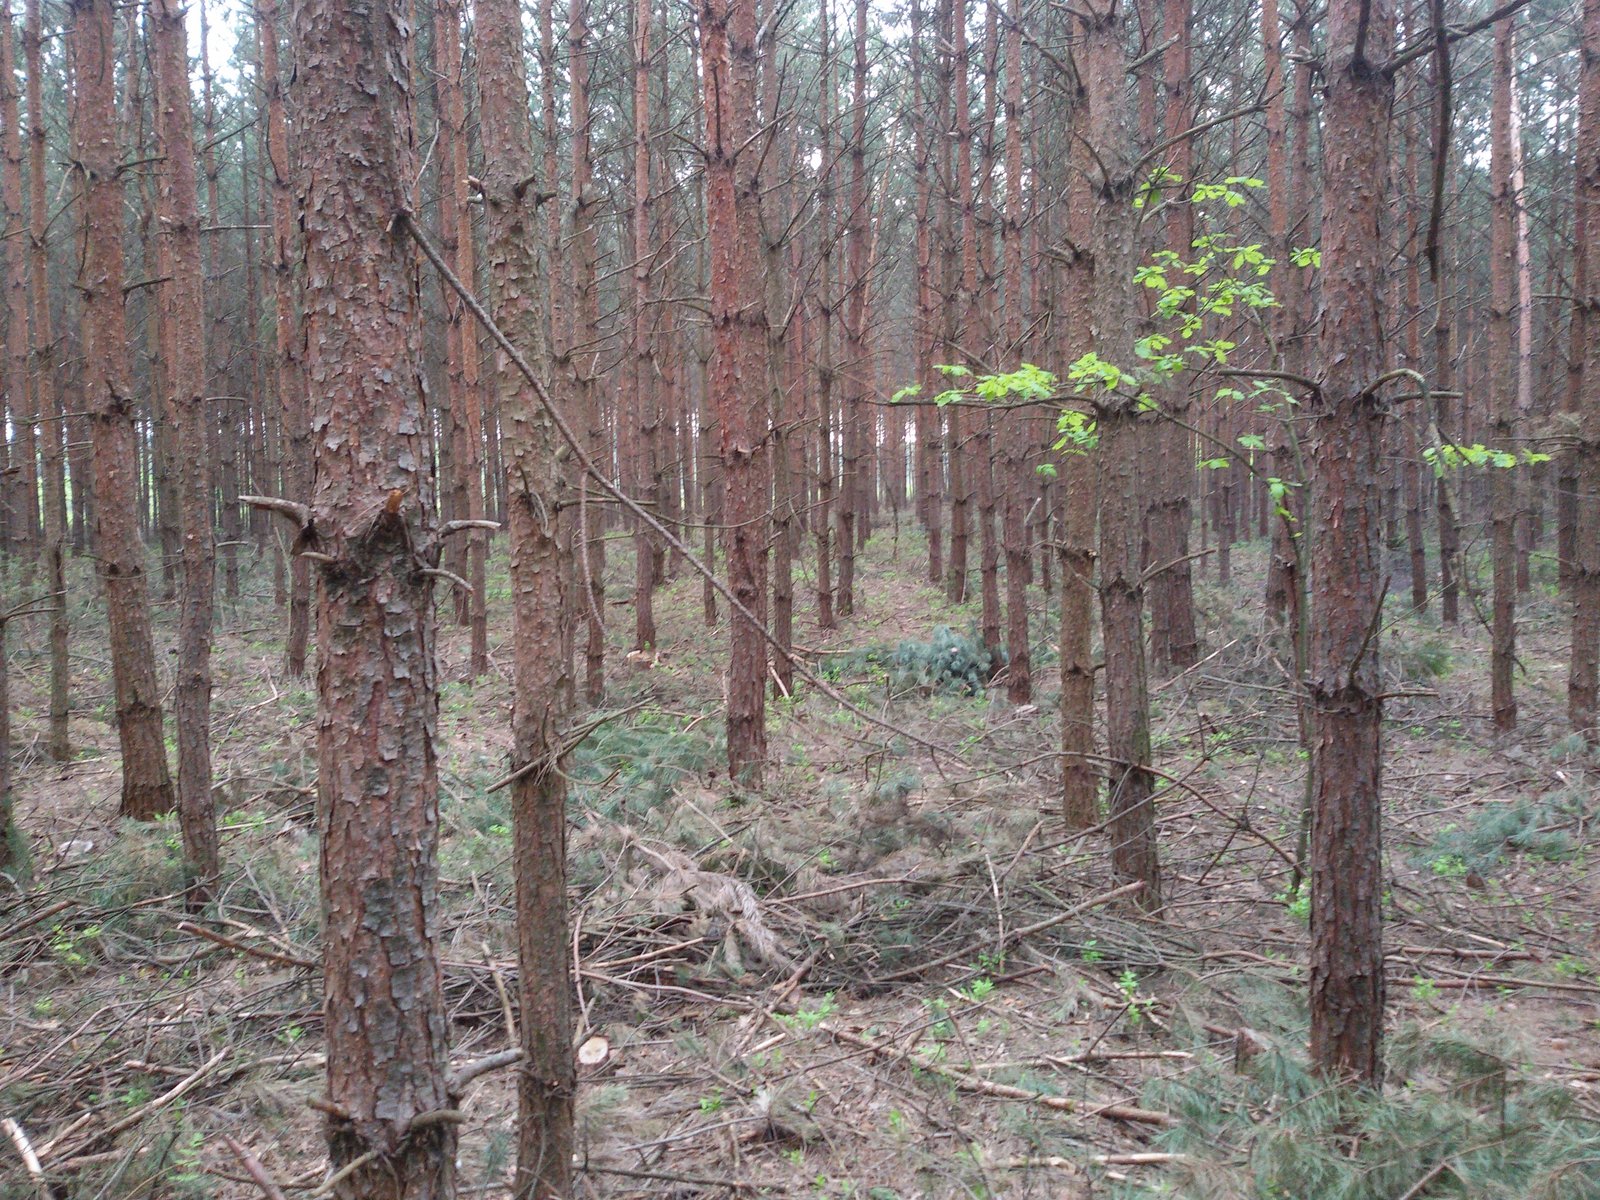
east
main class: Woodland
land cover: Pine dominated coniferous woodland
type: hemiboreal forest and nemoral coniferous forest and mixed broadleaved-coniferous forest
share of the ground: > 75 %
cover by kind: coniferous forest trees 80 %, herbaceous plants 10 %, broadleaved forest trees 5 %, shrubs 5 %
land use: Forestry
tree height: > 5 m
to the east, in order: Pine dominated coniferous woodland; Tracks; Pine dominated coniferous woodland; Tracks; Fences; Shrubland with sparse tree cover; Pine dominated mixed woodland
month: May
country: PL
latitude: 50.4397
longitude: 21.6407
